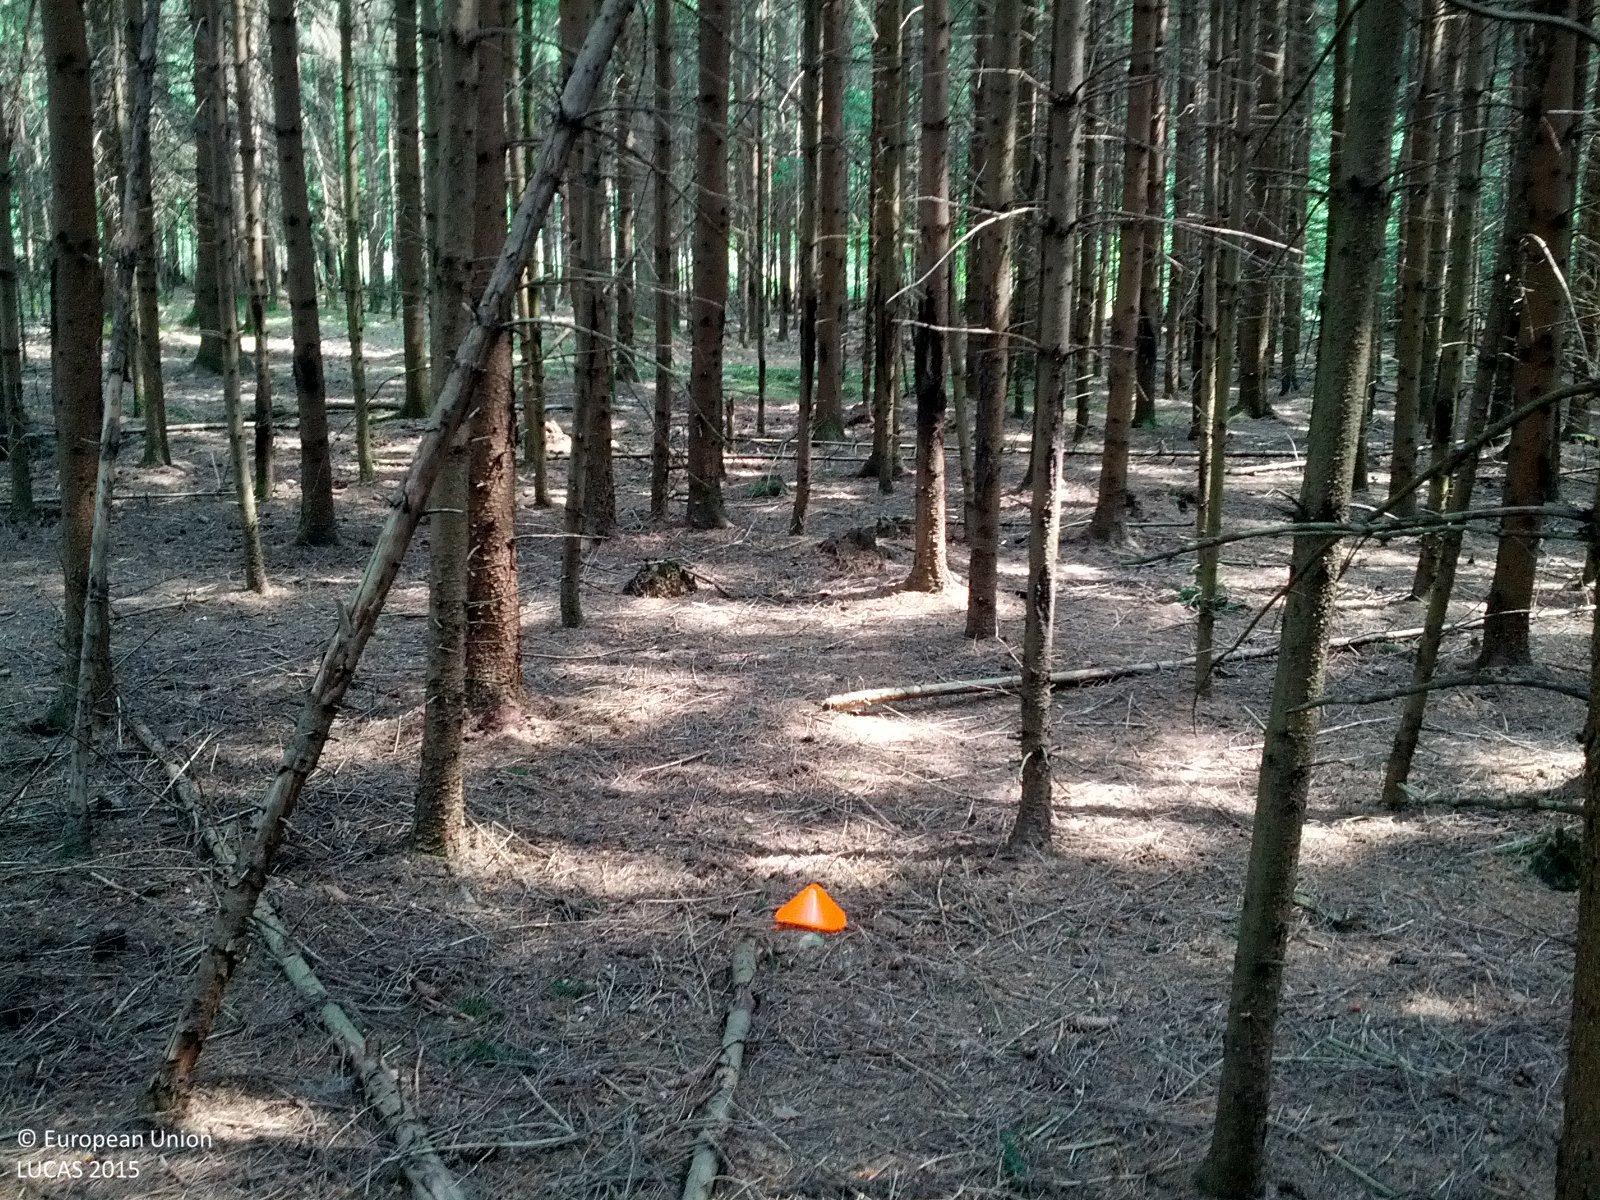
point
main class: Woodland
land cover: Spruce dominated coniferous woodland
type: boreal forest
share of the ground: > 75 %
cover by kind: coniferous forest trees 70 %, unconsolidated bare surface 30 %
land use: Forestry
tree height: > 5 m
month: May
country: AT
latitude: 47.3116
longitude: 16.1533
